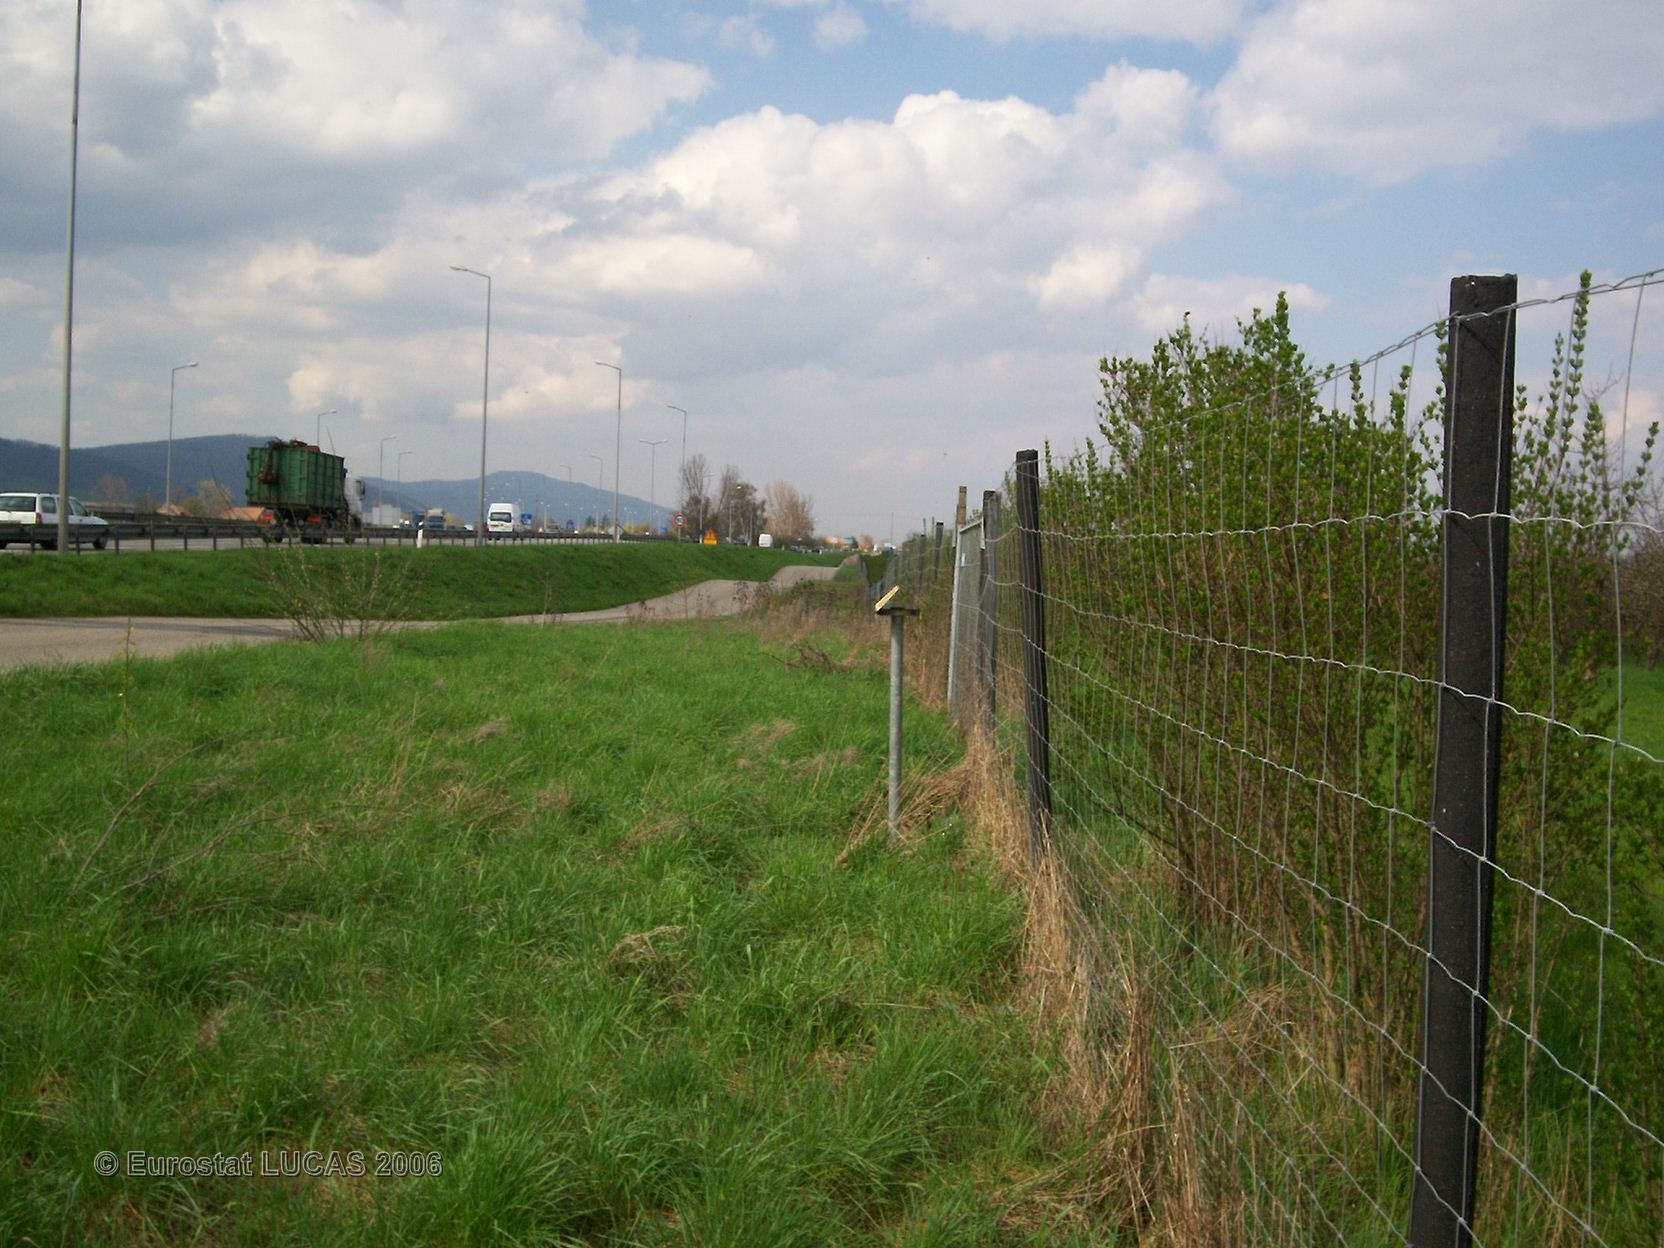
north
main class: Cropland
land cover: Apple fruit
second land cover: Grassland with sparse tree/shrub cover
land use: Agriculture (excluding fallow land and kitchen gardens)
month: April
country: FR
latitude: 48.2110
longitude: 7.4038
